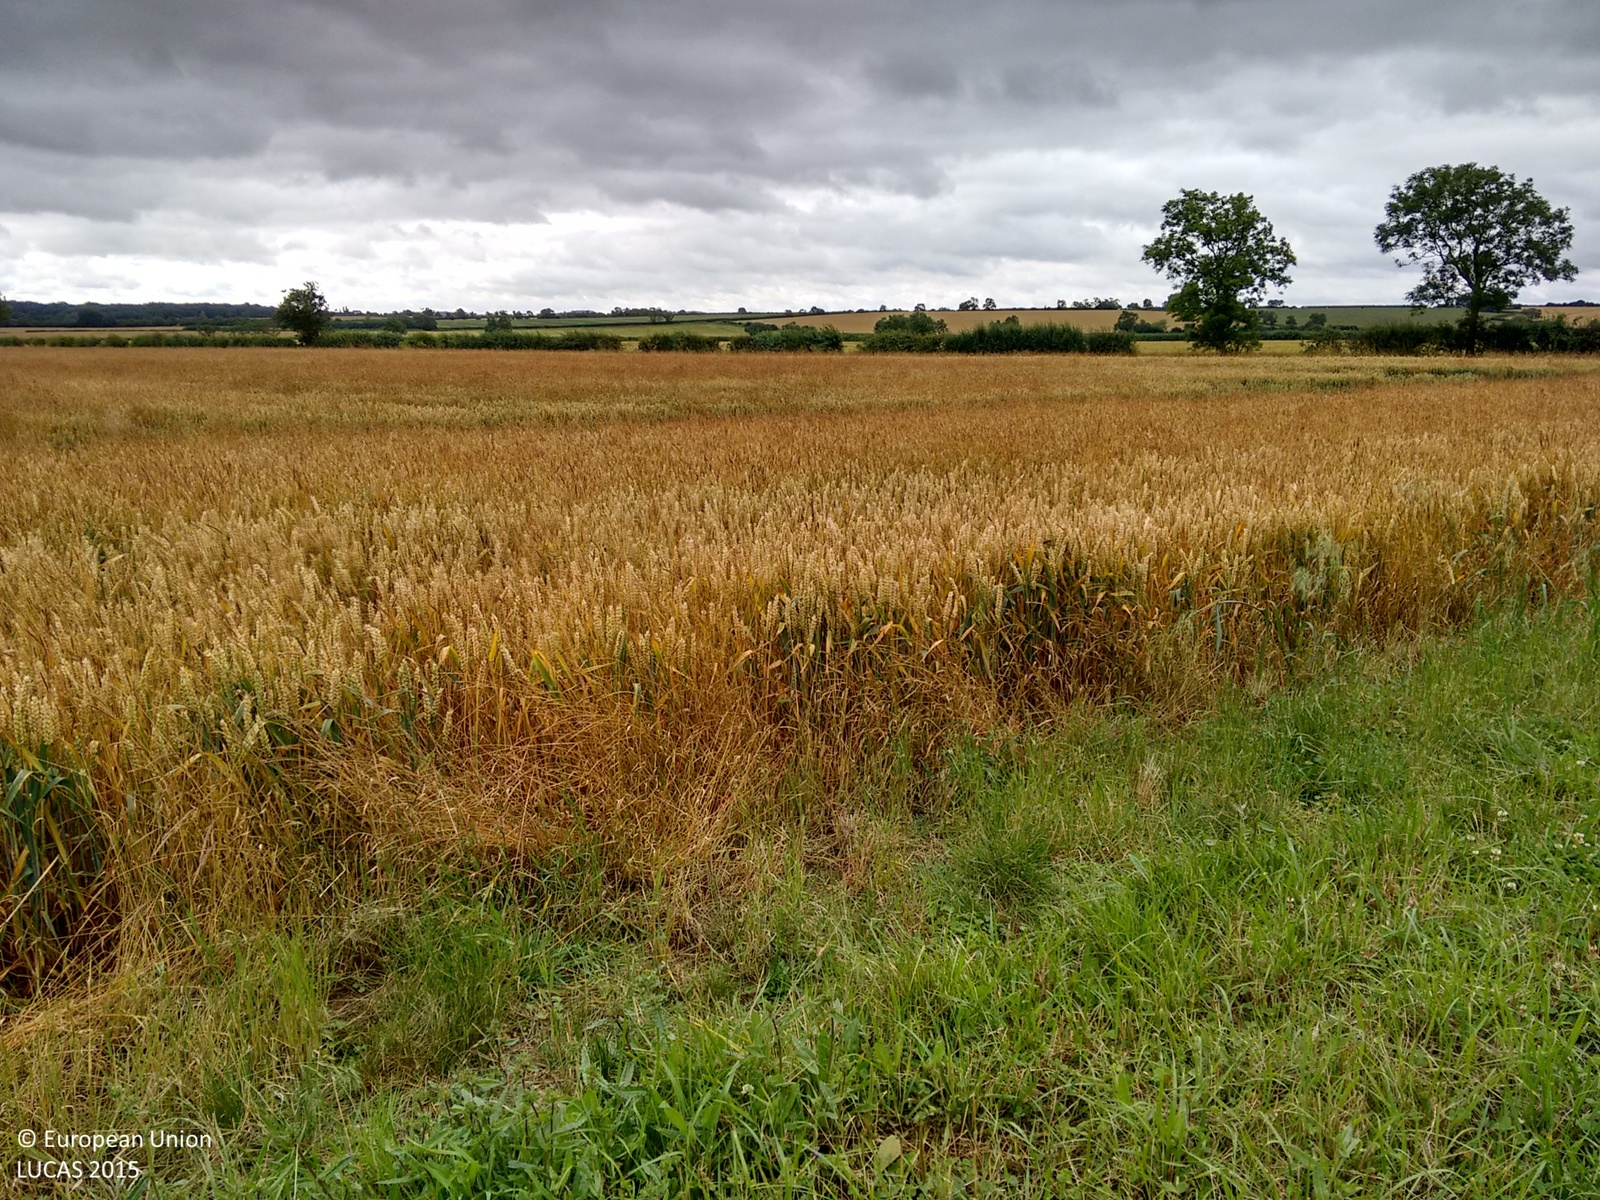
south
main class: Grassland
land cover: Grassland without tree/shrub cover
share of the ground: > 75 %
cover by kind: herbaceous plants 100 %
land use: Agriculture (excluding fallow land and kitchen gardens)
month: July
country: GB
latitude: 52.9561
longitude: -0.7735
